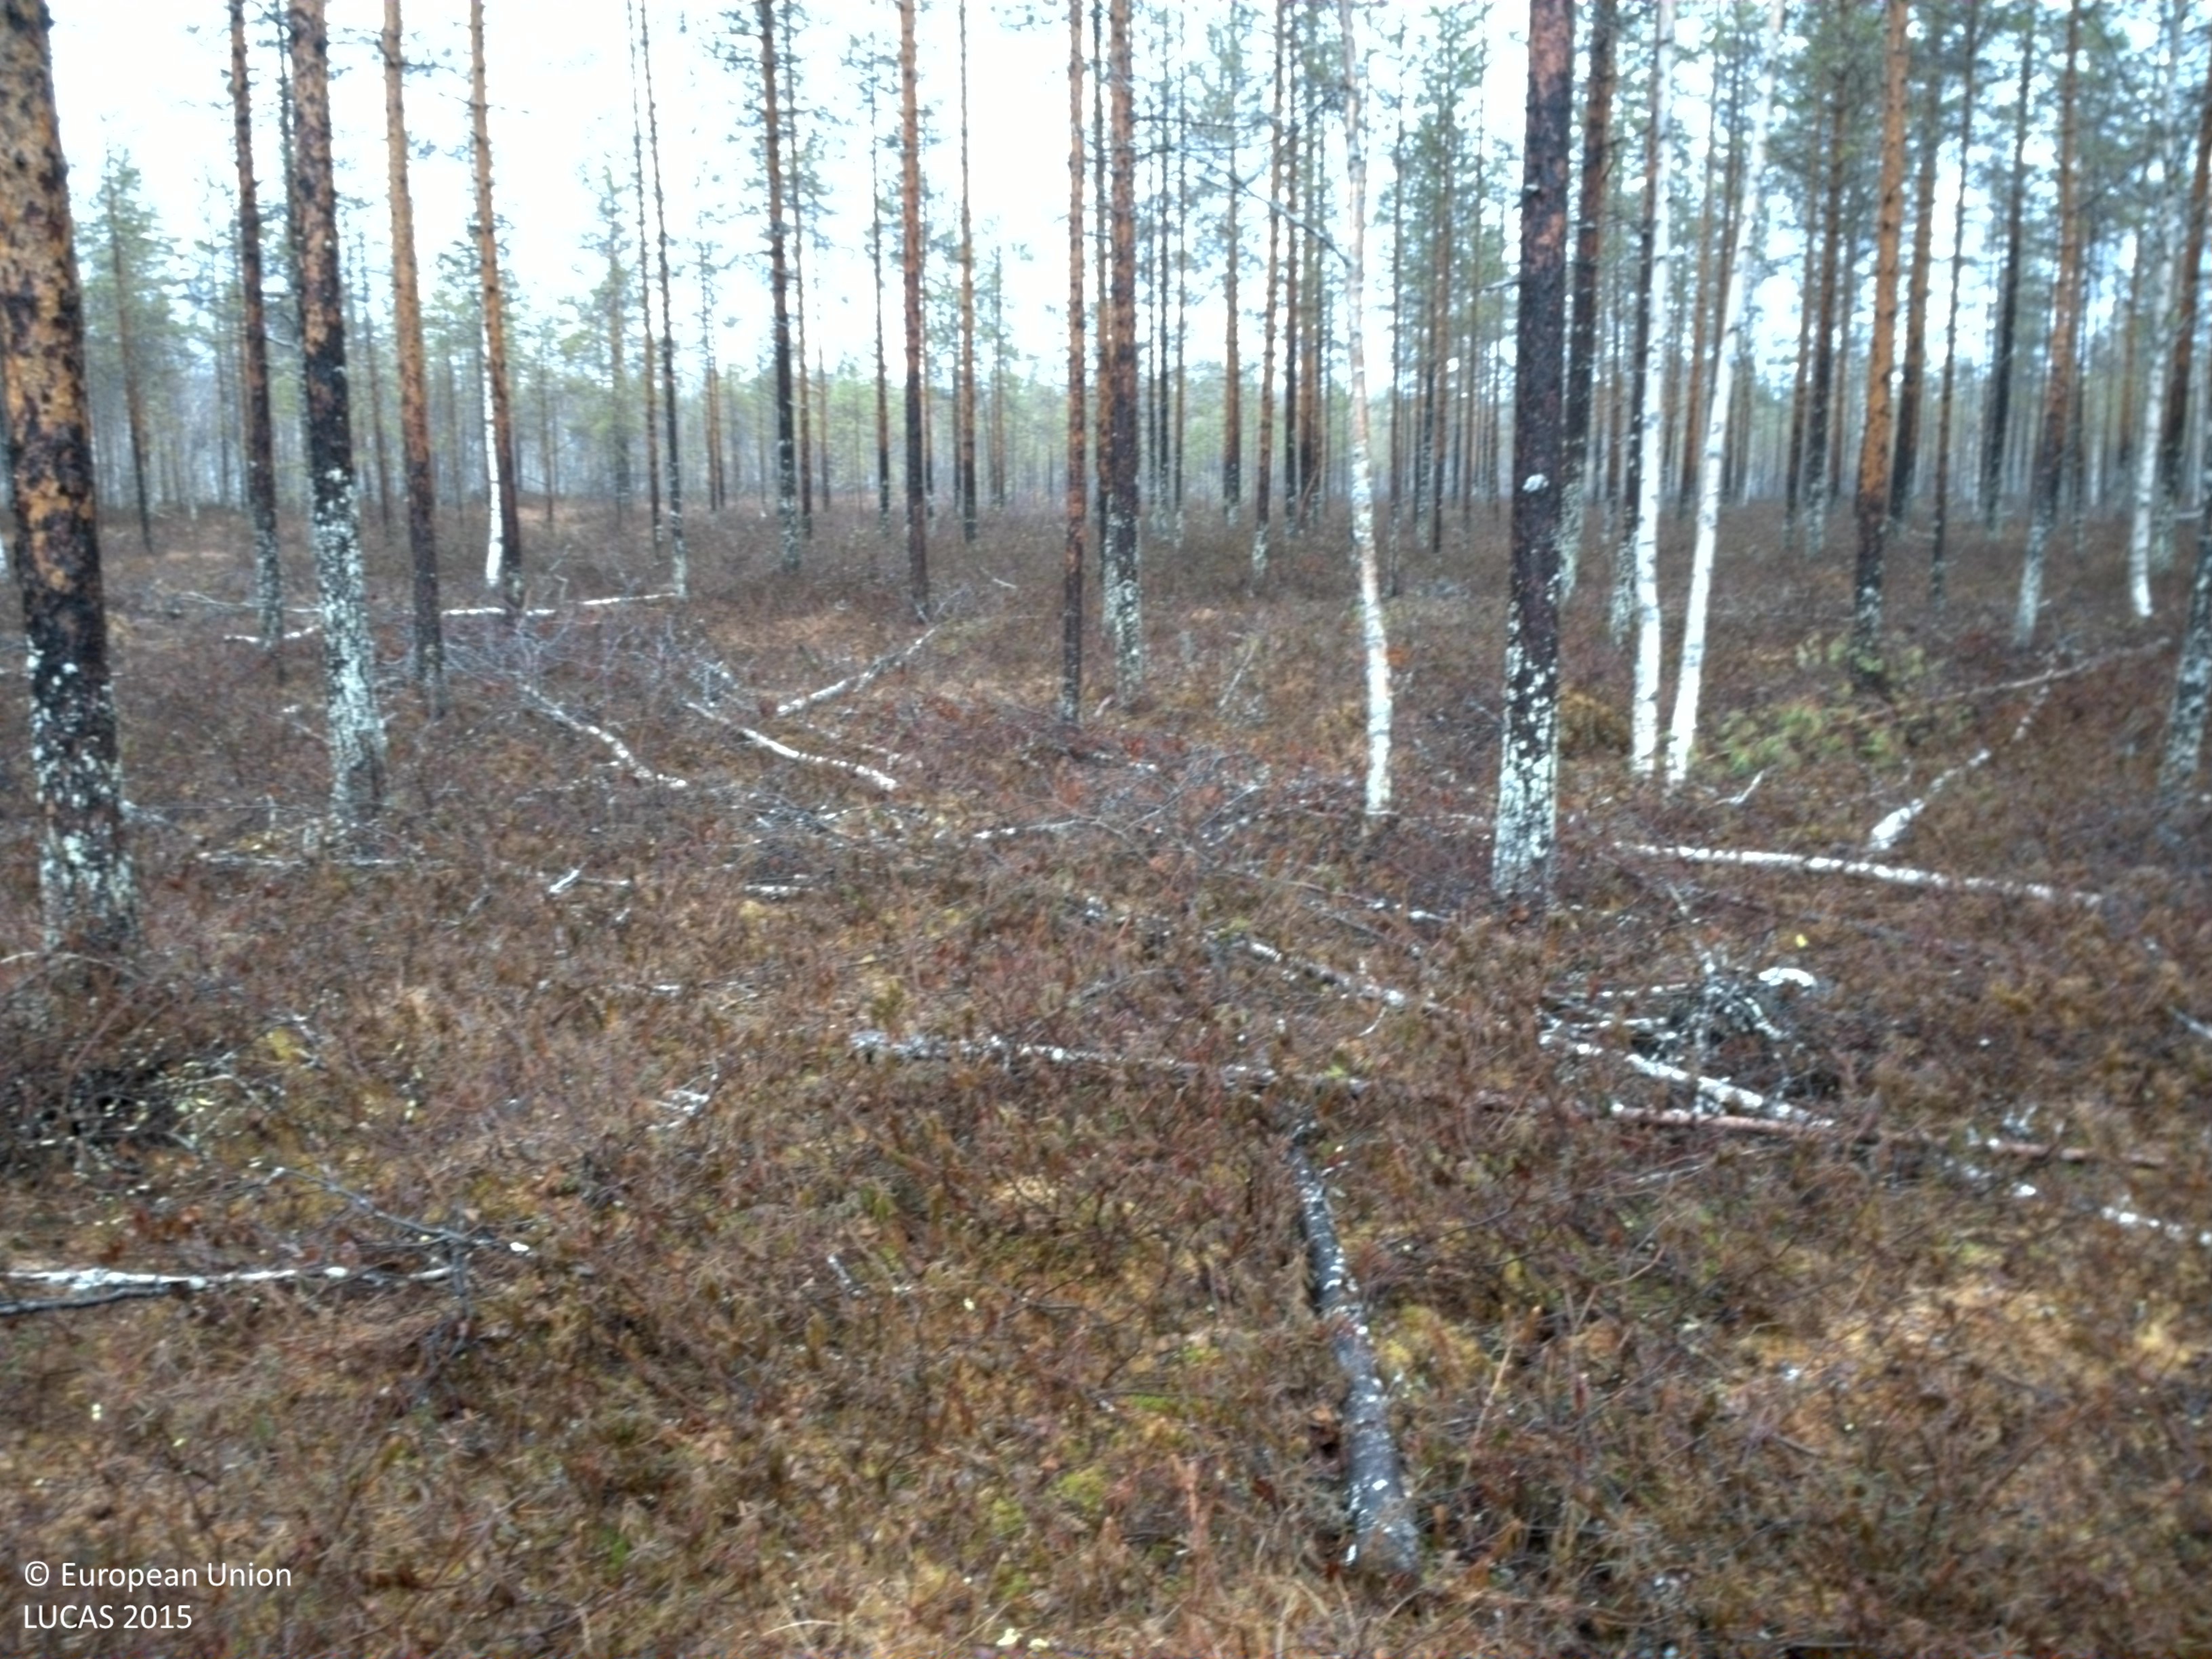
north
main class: Woodland
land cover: Pine dominated coniferous woodland
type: boreal forest
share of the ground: 50 - 75 %
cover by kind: coniferous forest trees 75 %, shrubs 25 %
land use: Forestry
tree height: > 5 m
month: May
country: SE
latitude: 65.8585
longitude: 23.2905
